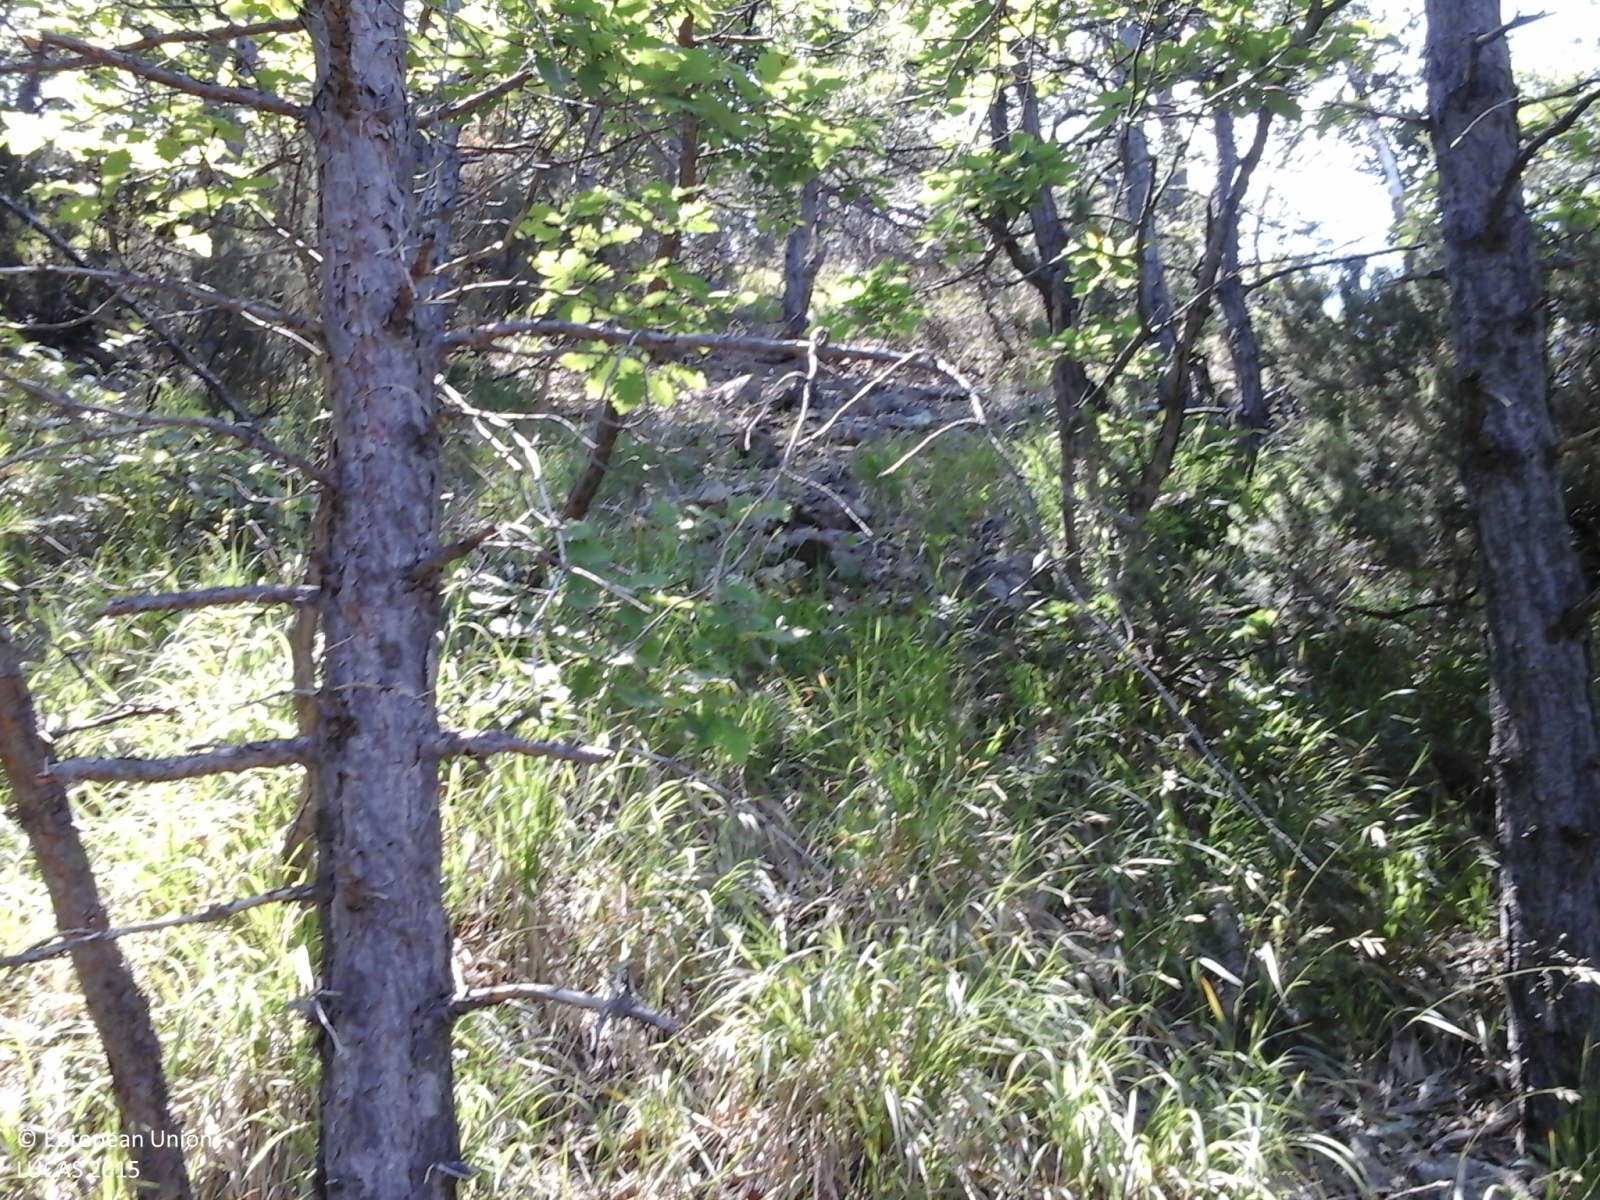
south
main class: Woodland
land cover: Pine dominated mixed woodland
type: coniferous forest of the mediterranean region
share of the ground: > 75 %
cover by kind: coniferous forest trees 45 %, broadleaved forest trees 25 %, shrubs 15 %, herbaceous plants 10 %, consolidated bare surface 5 %
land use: Forestry
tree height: > 5 m
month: June
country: IT
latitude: 44.5202
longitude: 8.5060
